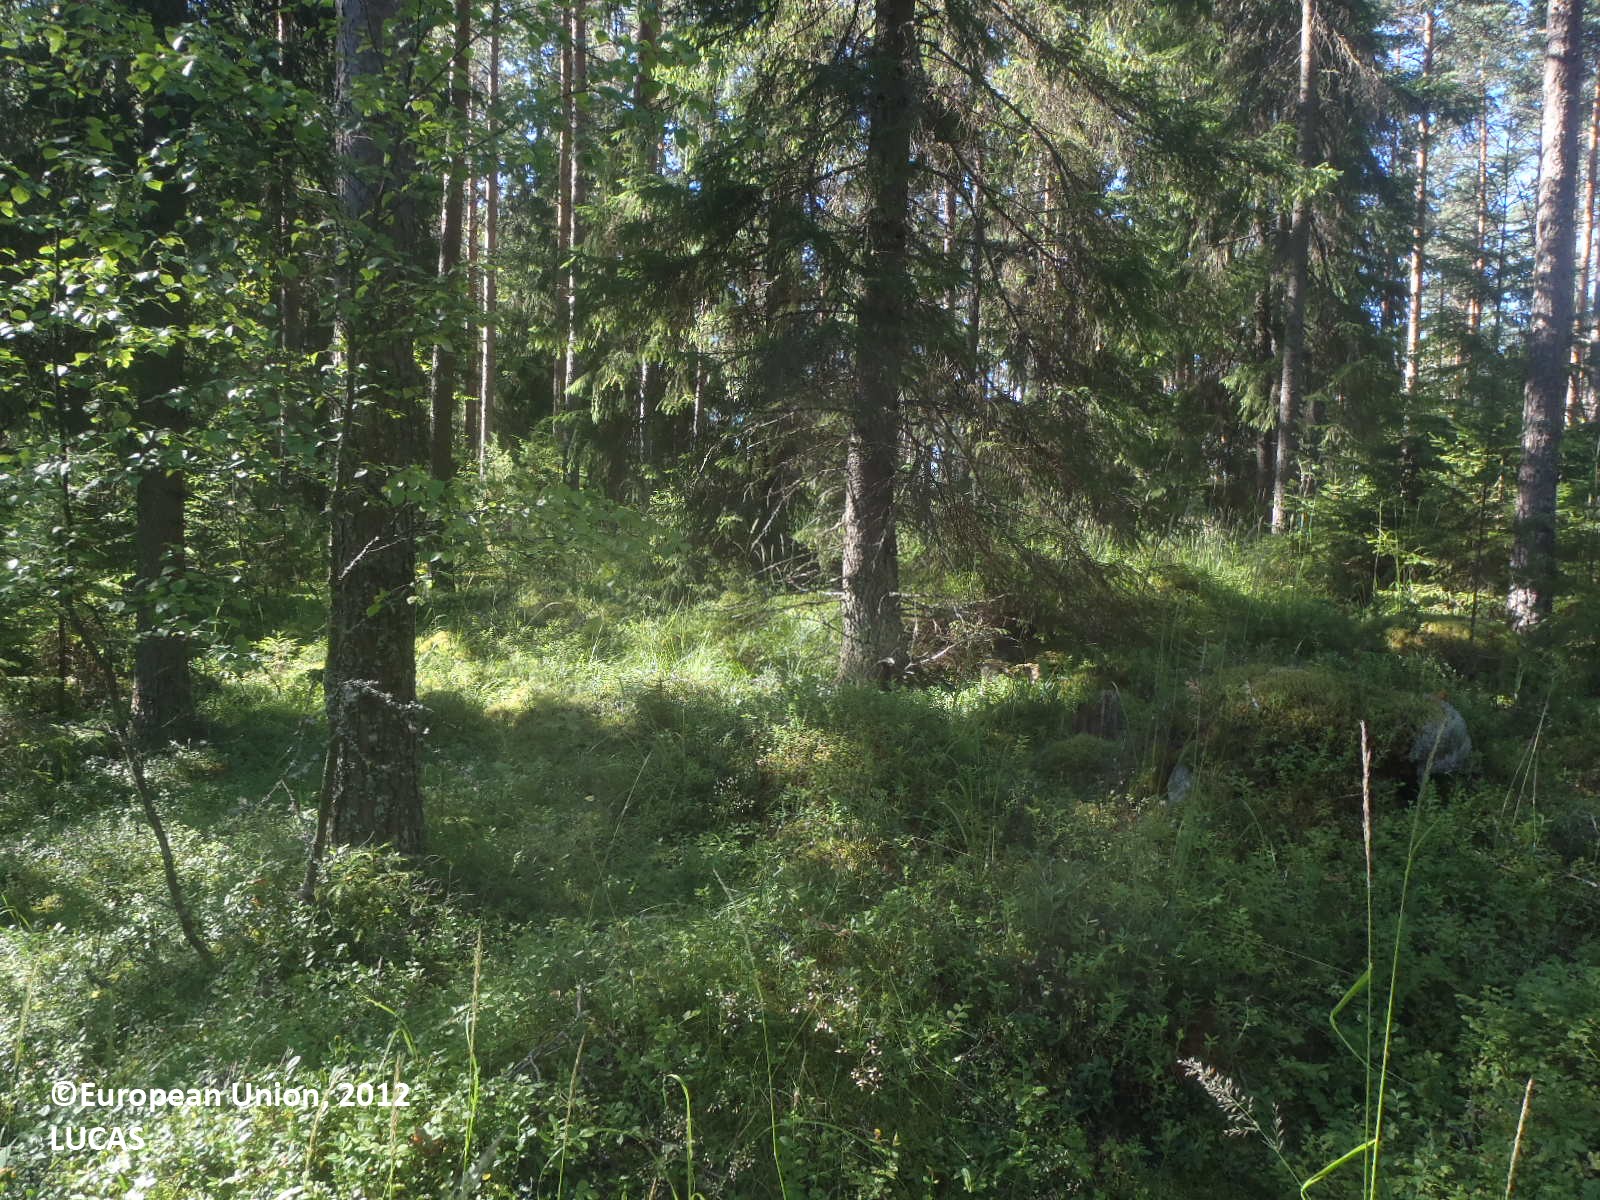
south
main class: Woodland
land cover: Pine dominated coniferous woodland
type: boreal forest
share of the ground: 50 - 75 %
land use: Forestry
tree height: > 5 m
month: July
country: FI
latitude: 61.0732
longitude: 21.9762
